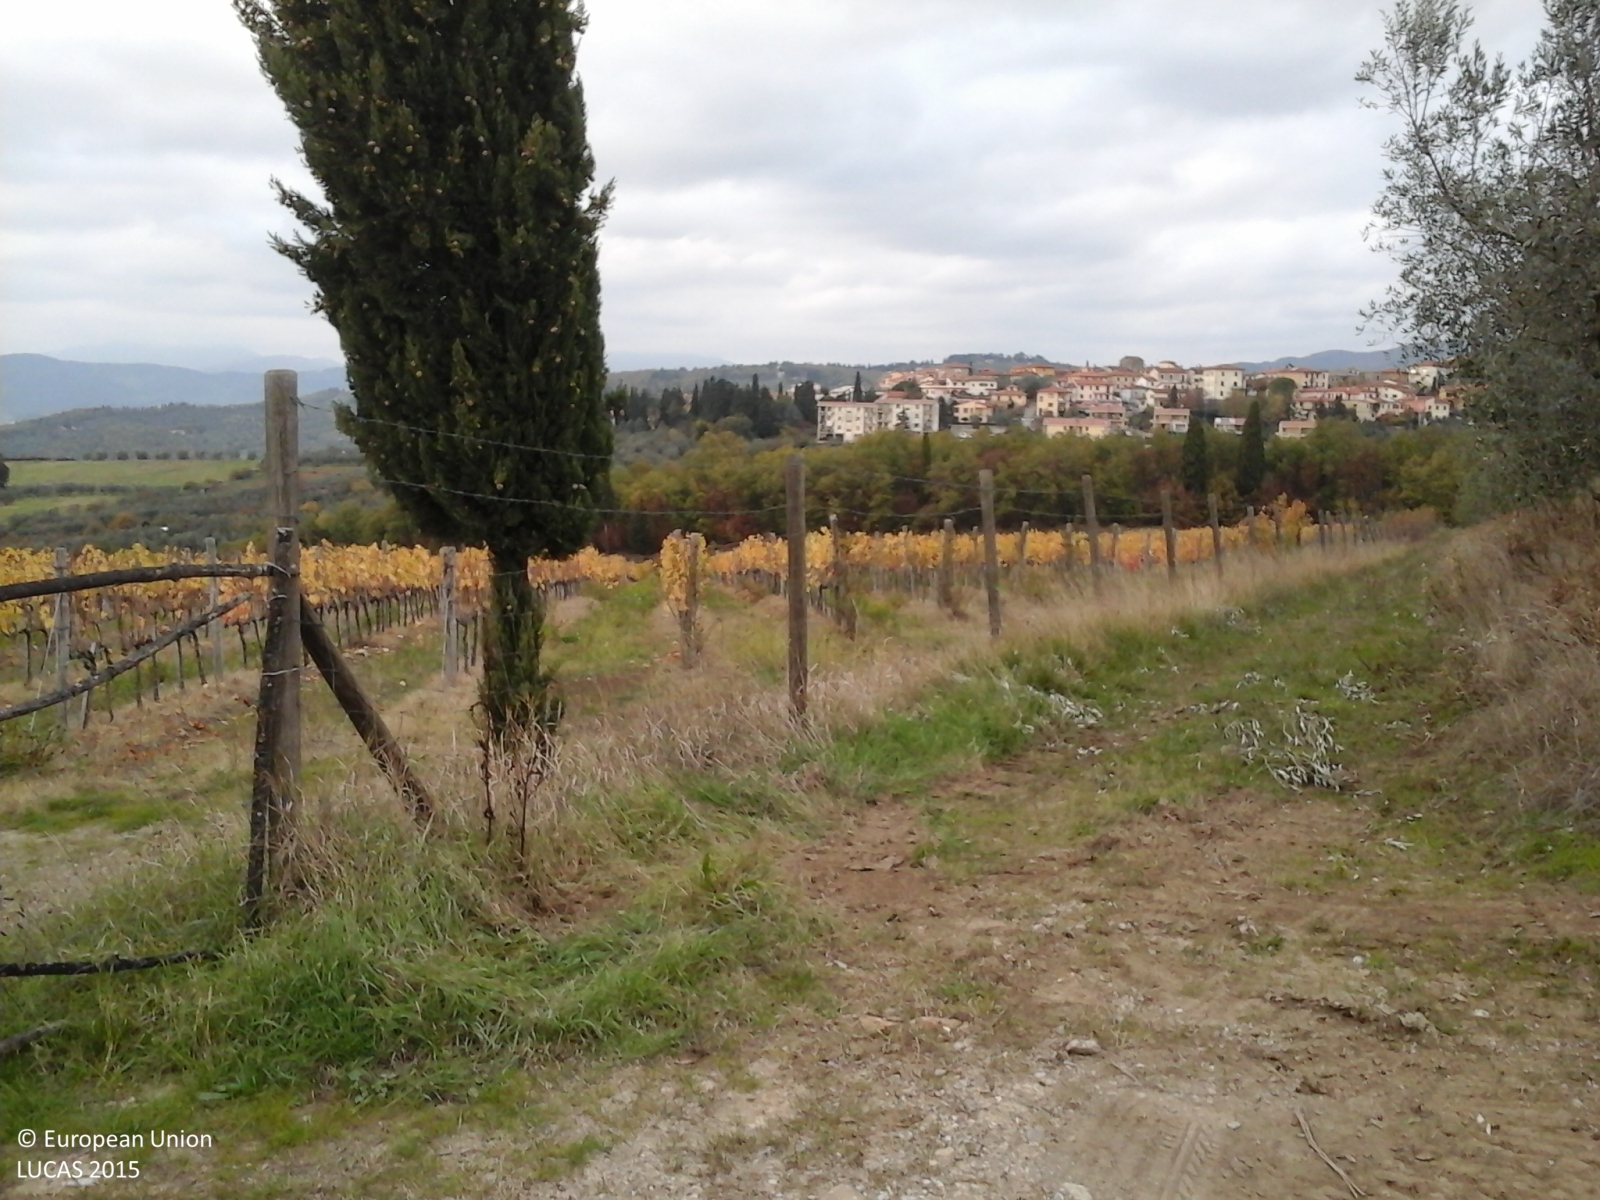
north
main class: Cropland
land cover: Vineyards
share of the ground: 25 - 50 %
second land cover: Grassland without tree/shrub cover
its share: 50 - 75 %
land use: Agriculture (excluding fallow land and kitchen gardens)
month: September
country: IT
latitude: 43.7263
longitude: 11.4982
